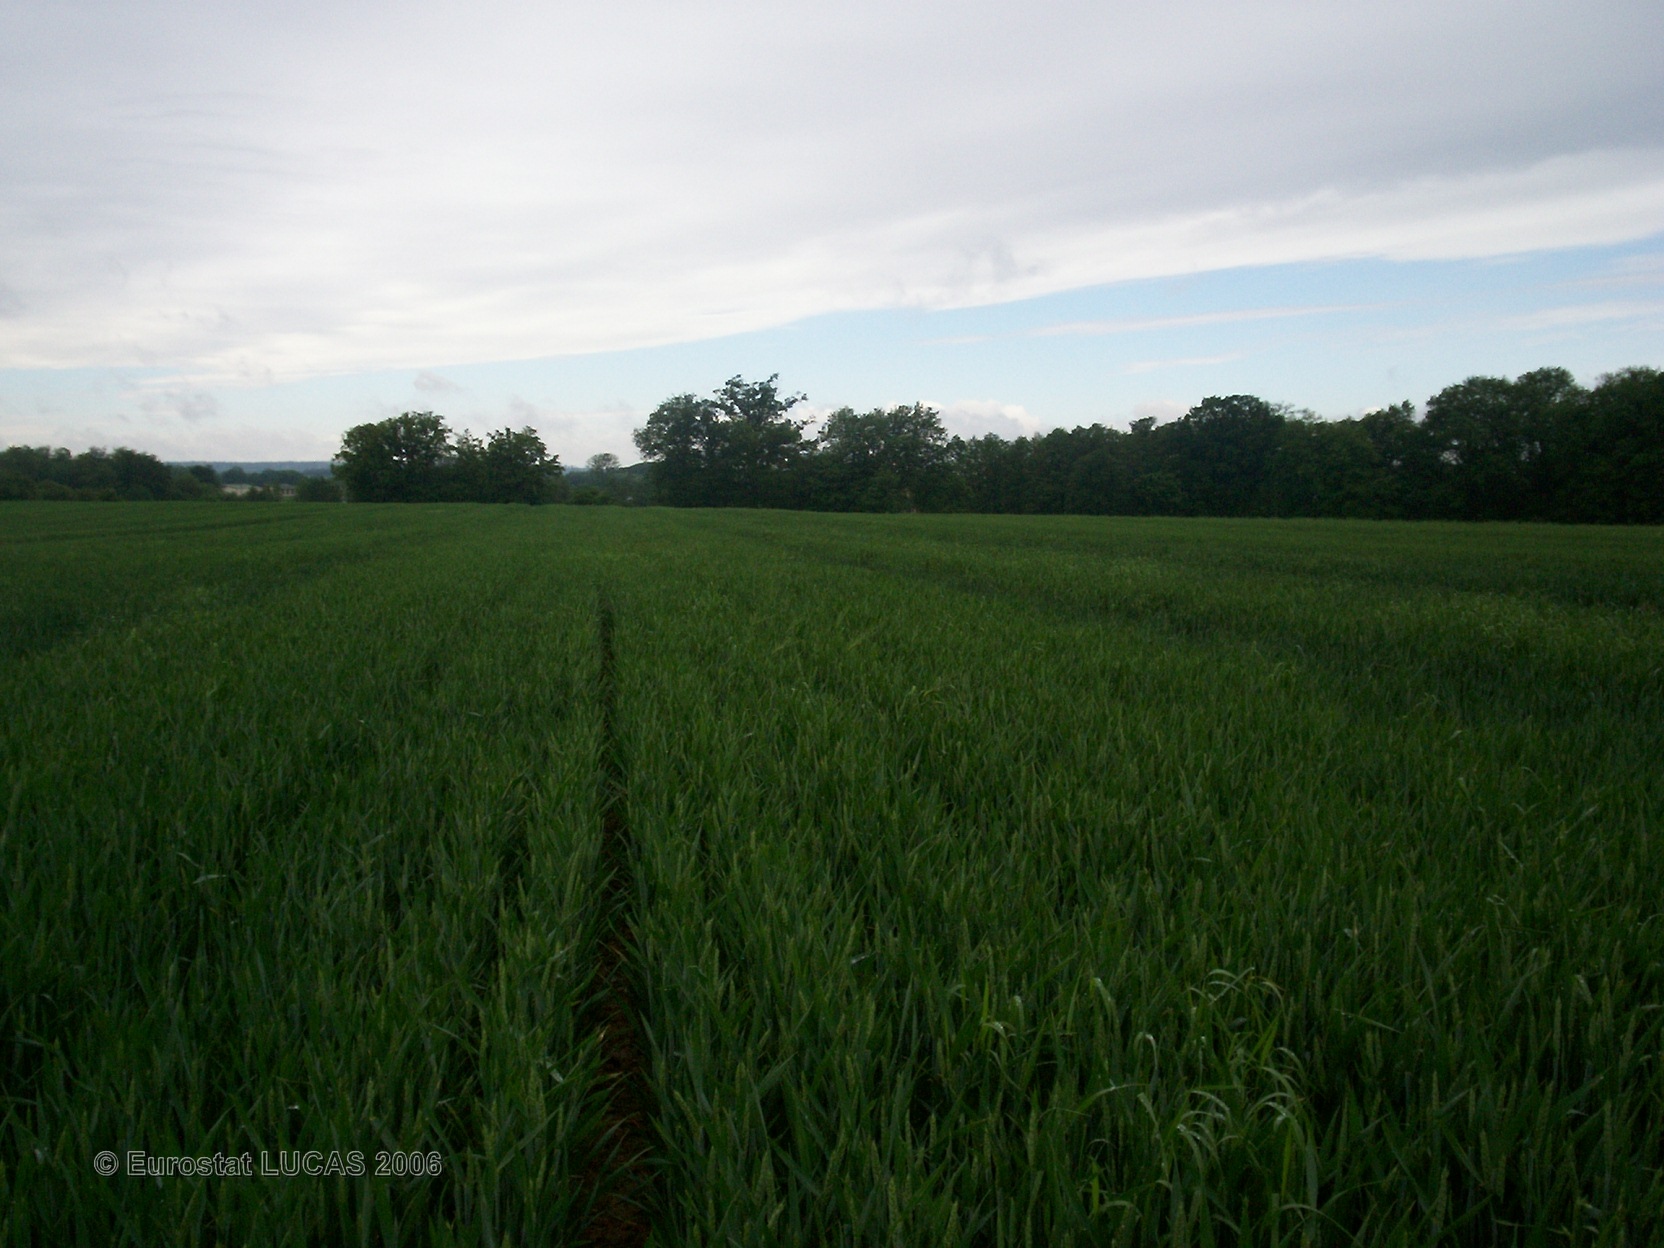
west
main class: Cropland
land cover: Common wheat
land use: Agriculture (excluding fallow land and kitchen gardens)
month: May
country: FR
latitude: 48.5542
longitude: 6.7626
